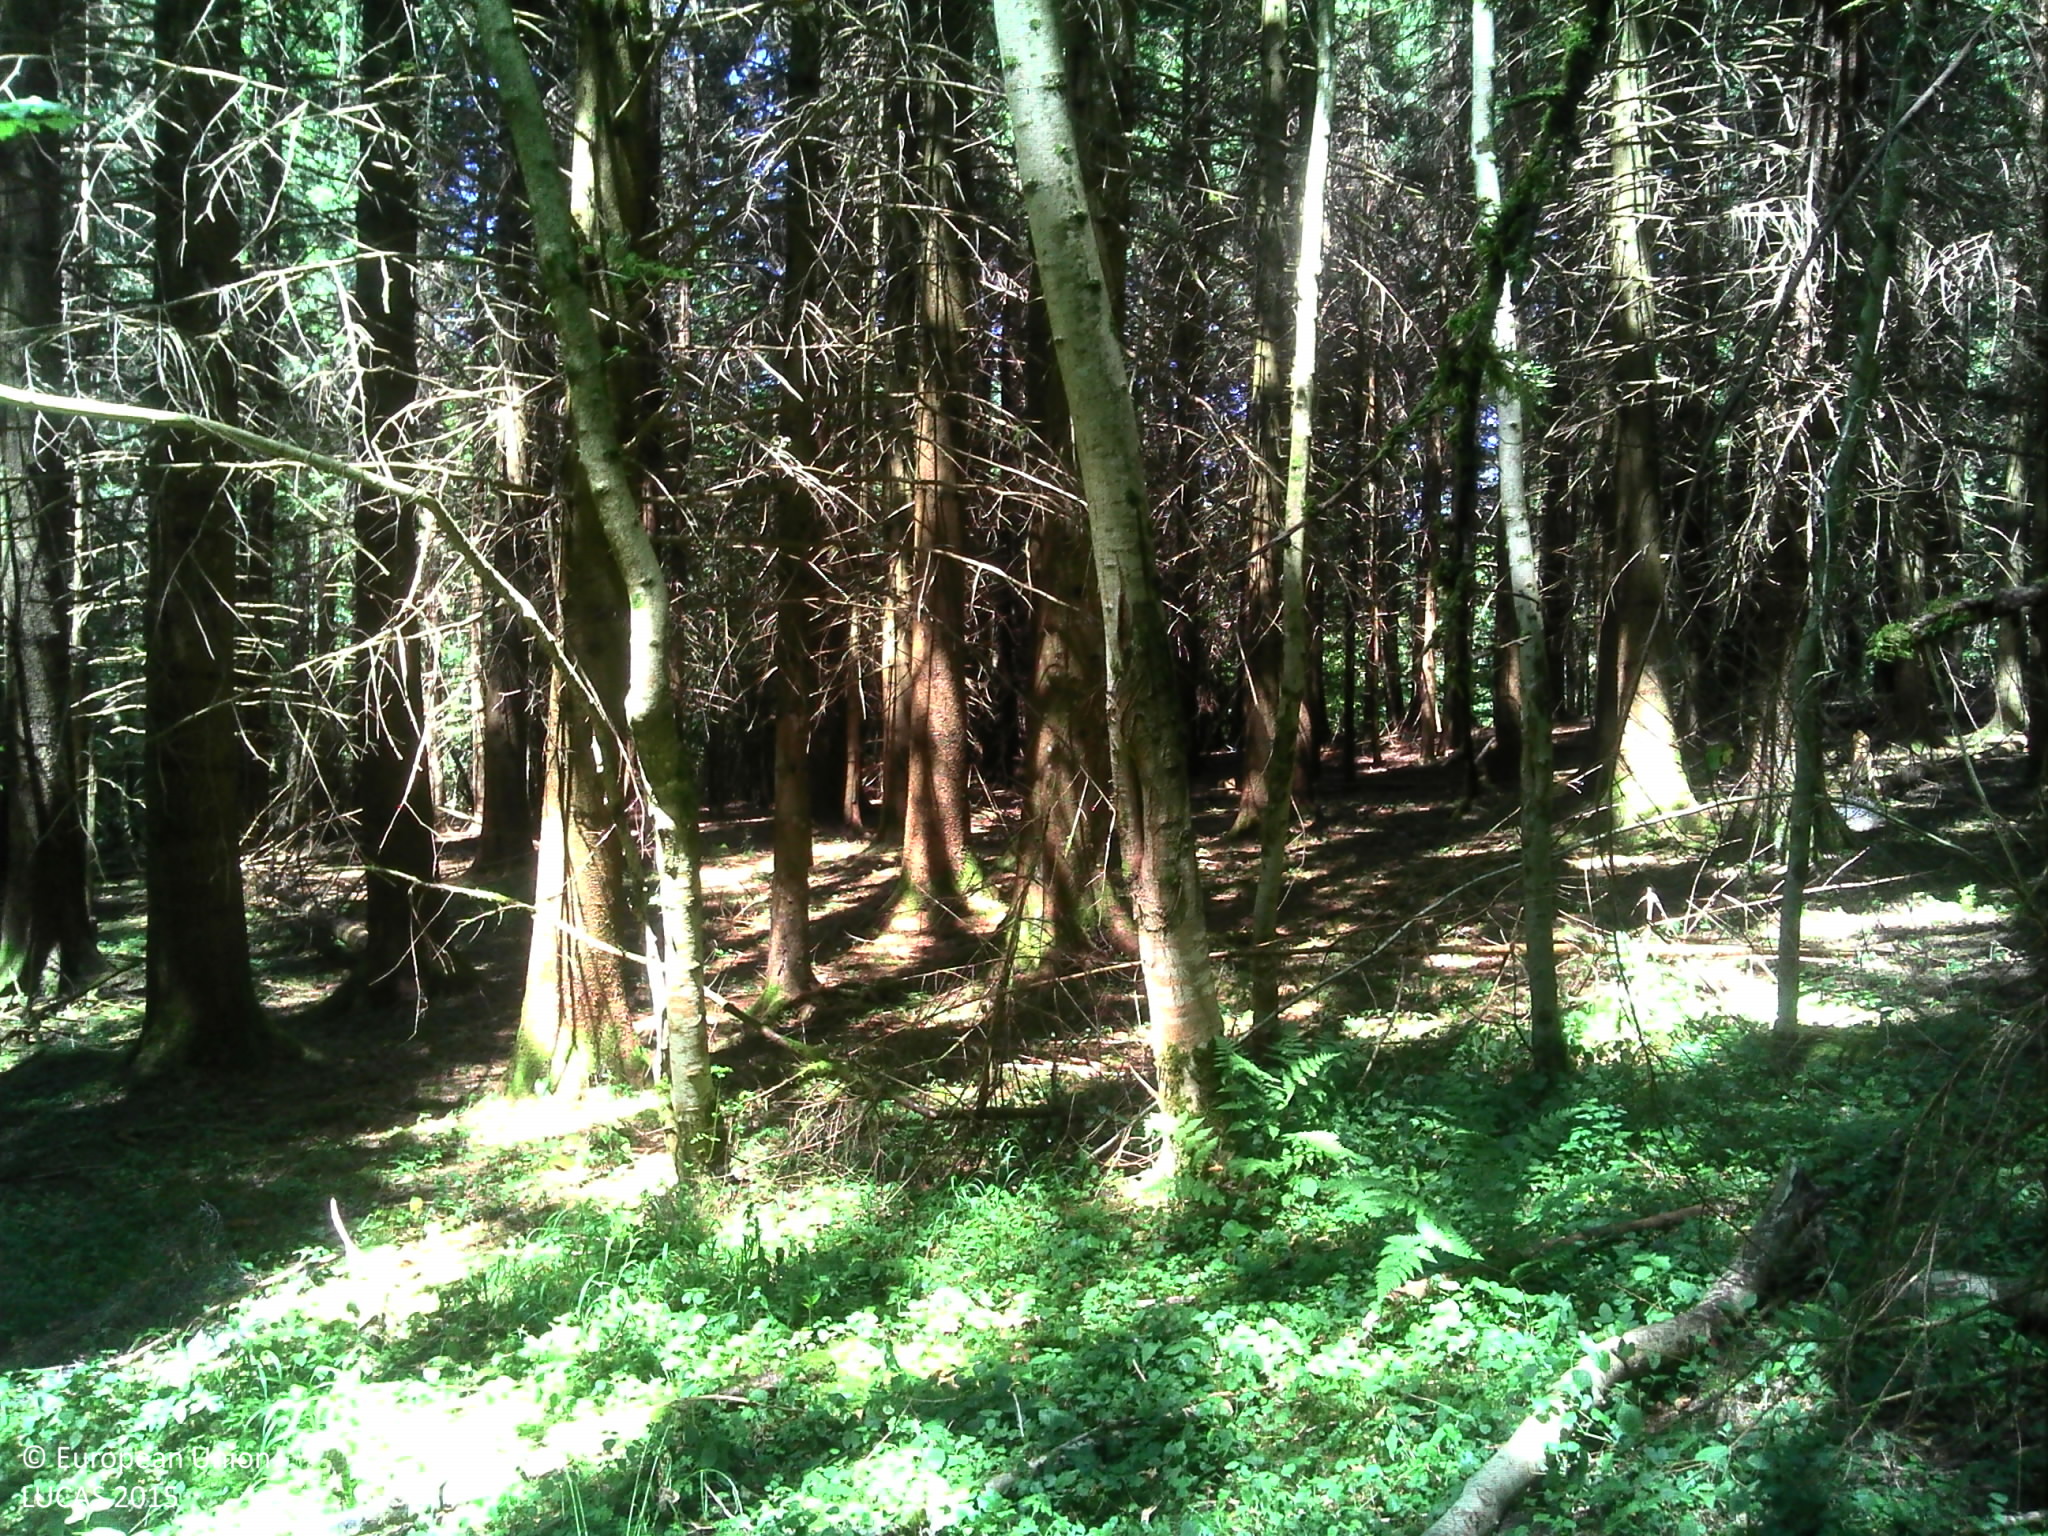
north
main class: Woodland
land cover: Spruce dominated coniferous woodland
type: exotic forest
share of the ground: > 75 %
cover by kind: coniferous forest trees 60 %, broadleaved forest trees 15 %, herbaceous plants 15 %, lichens and mosses 10 %
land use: Forestry
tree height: > 5 m
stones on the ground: < 10 %
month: July
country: FR
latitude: 46.2738
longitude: 6.4348
